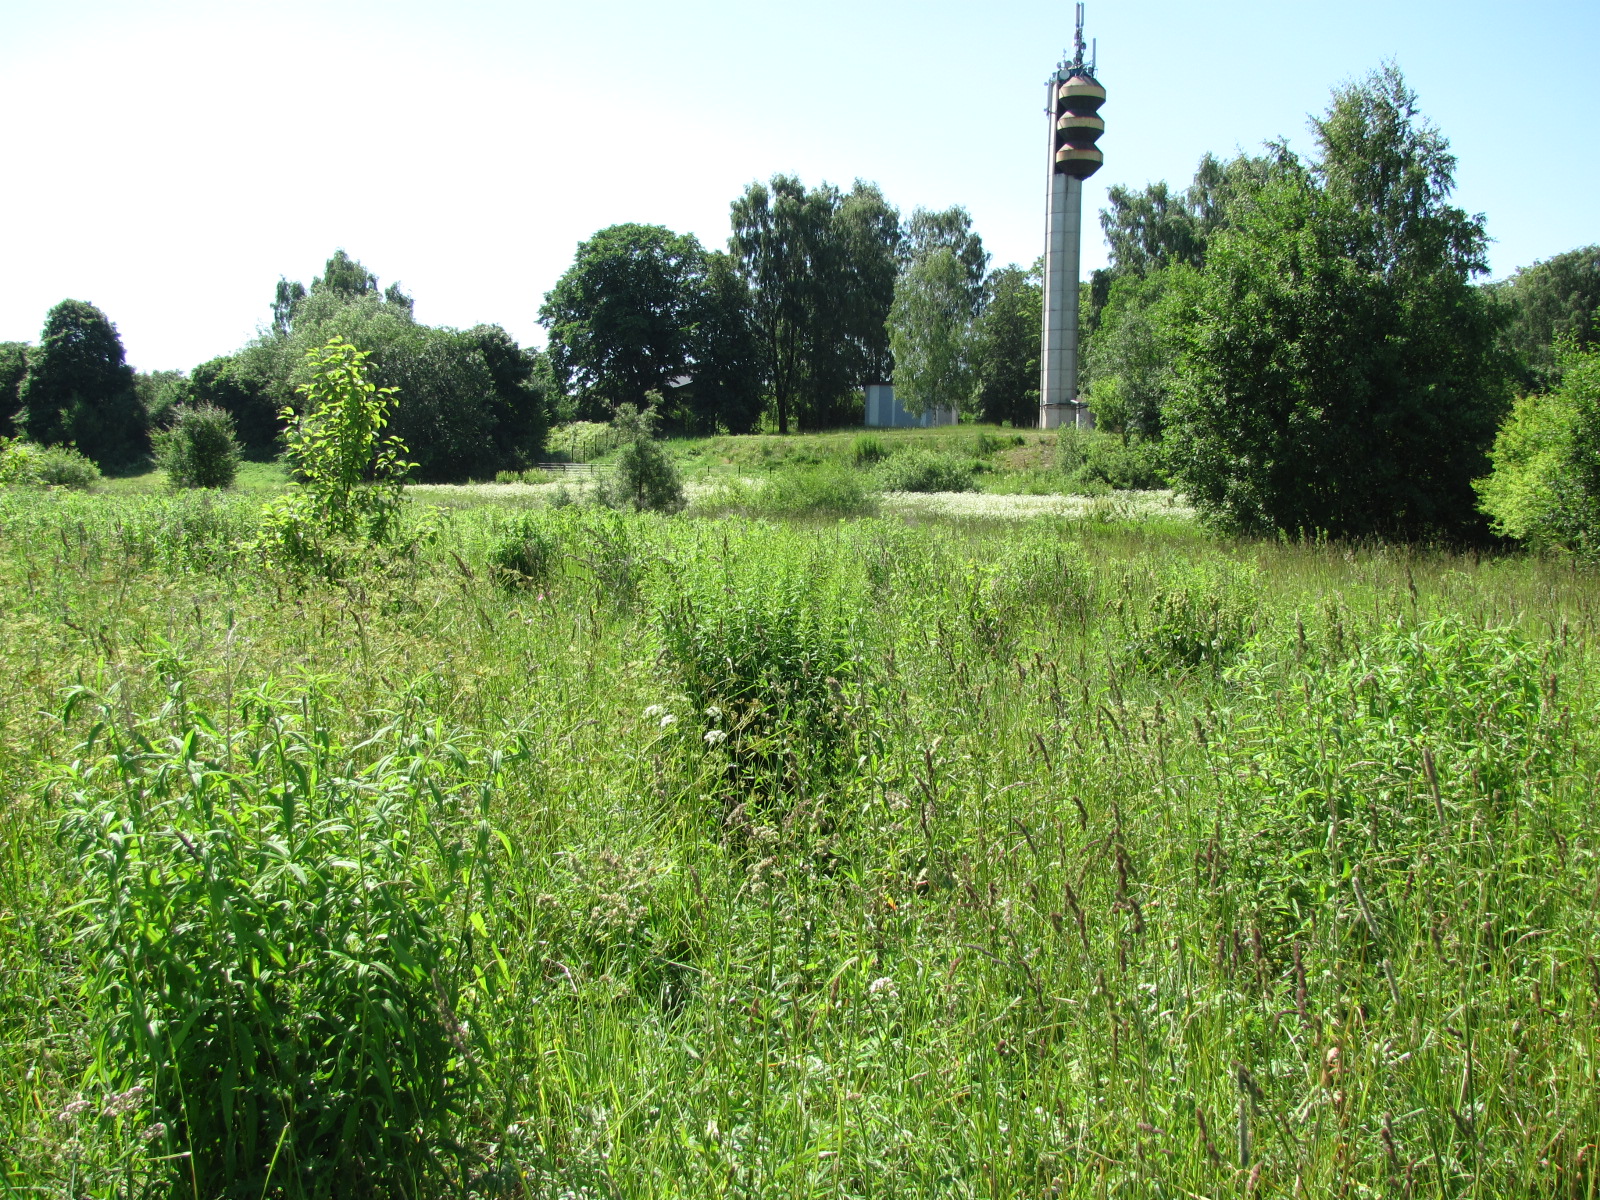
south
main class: Grassland
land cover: Grassland with sparse tree/shrub cover
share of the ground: > 75 %
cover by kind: herbaceous plants 95 %, broadleaved forest trees 5 %
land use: Abandoned areas
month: July
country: LV
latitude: 56.8763
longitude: 24.1820
